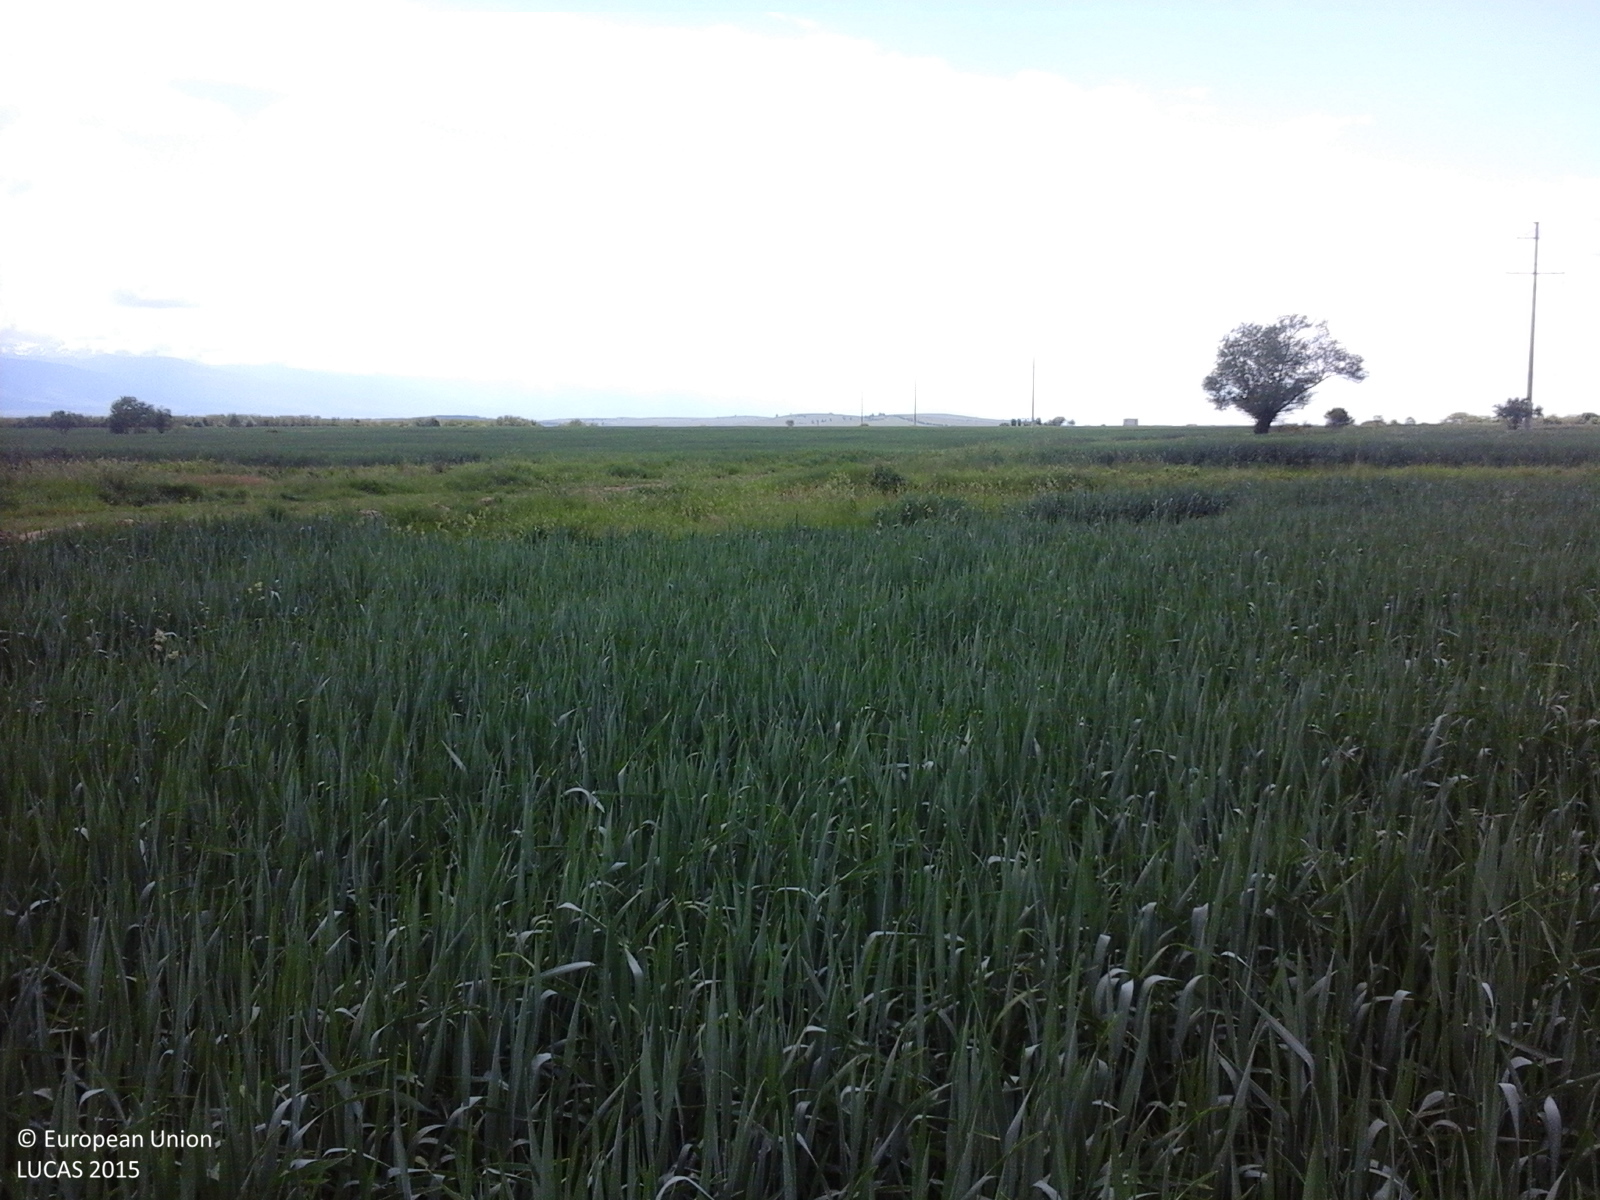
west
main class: Cropland
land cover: Rye
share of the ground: > 75 %
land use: Agriculture (excluding fallow land and kitchen gardens)
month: May
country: RO
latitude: 45.8291
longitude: 25.1702
